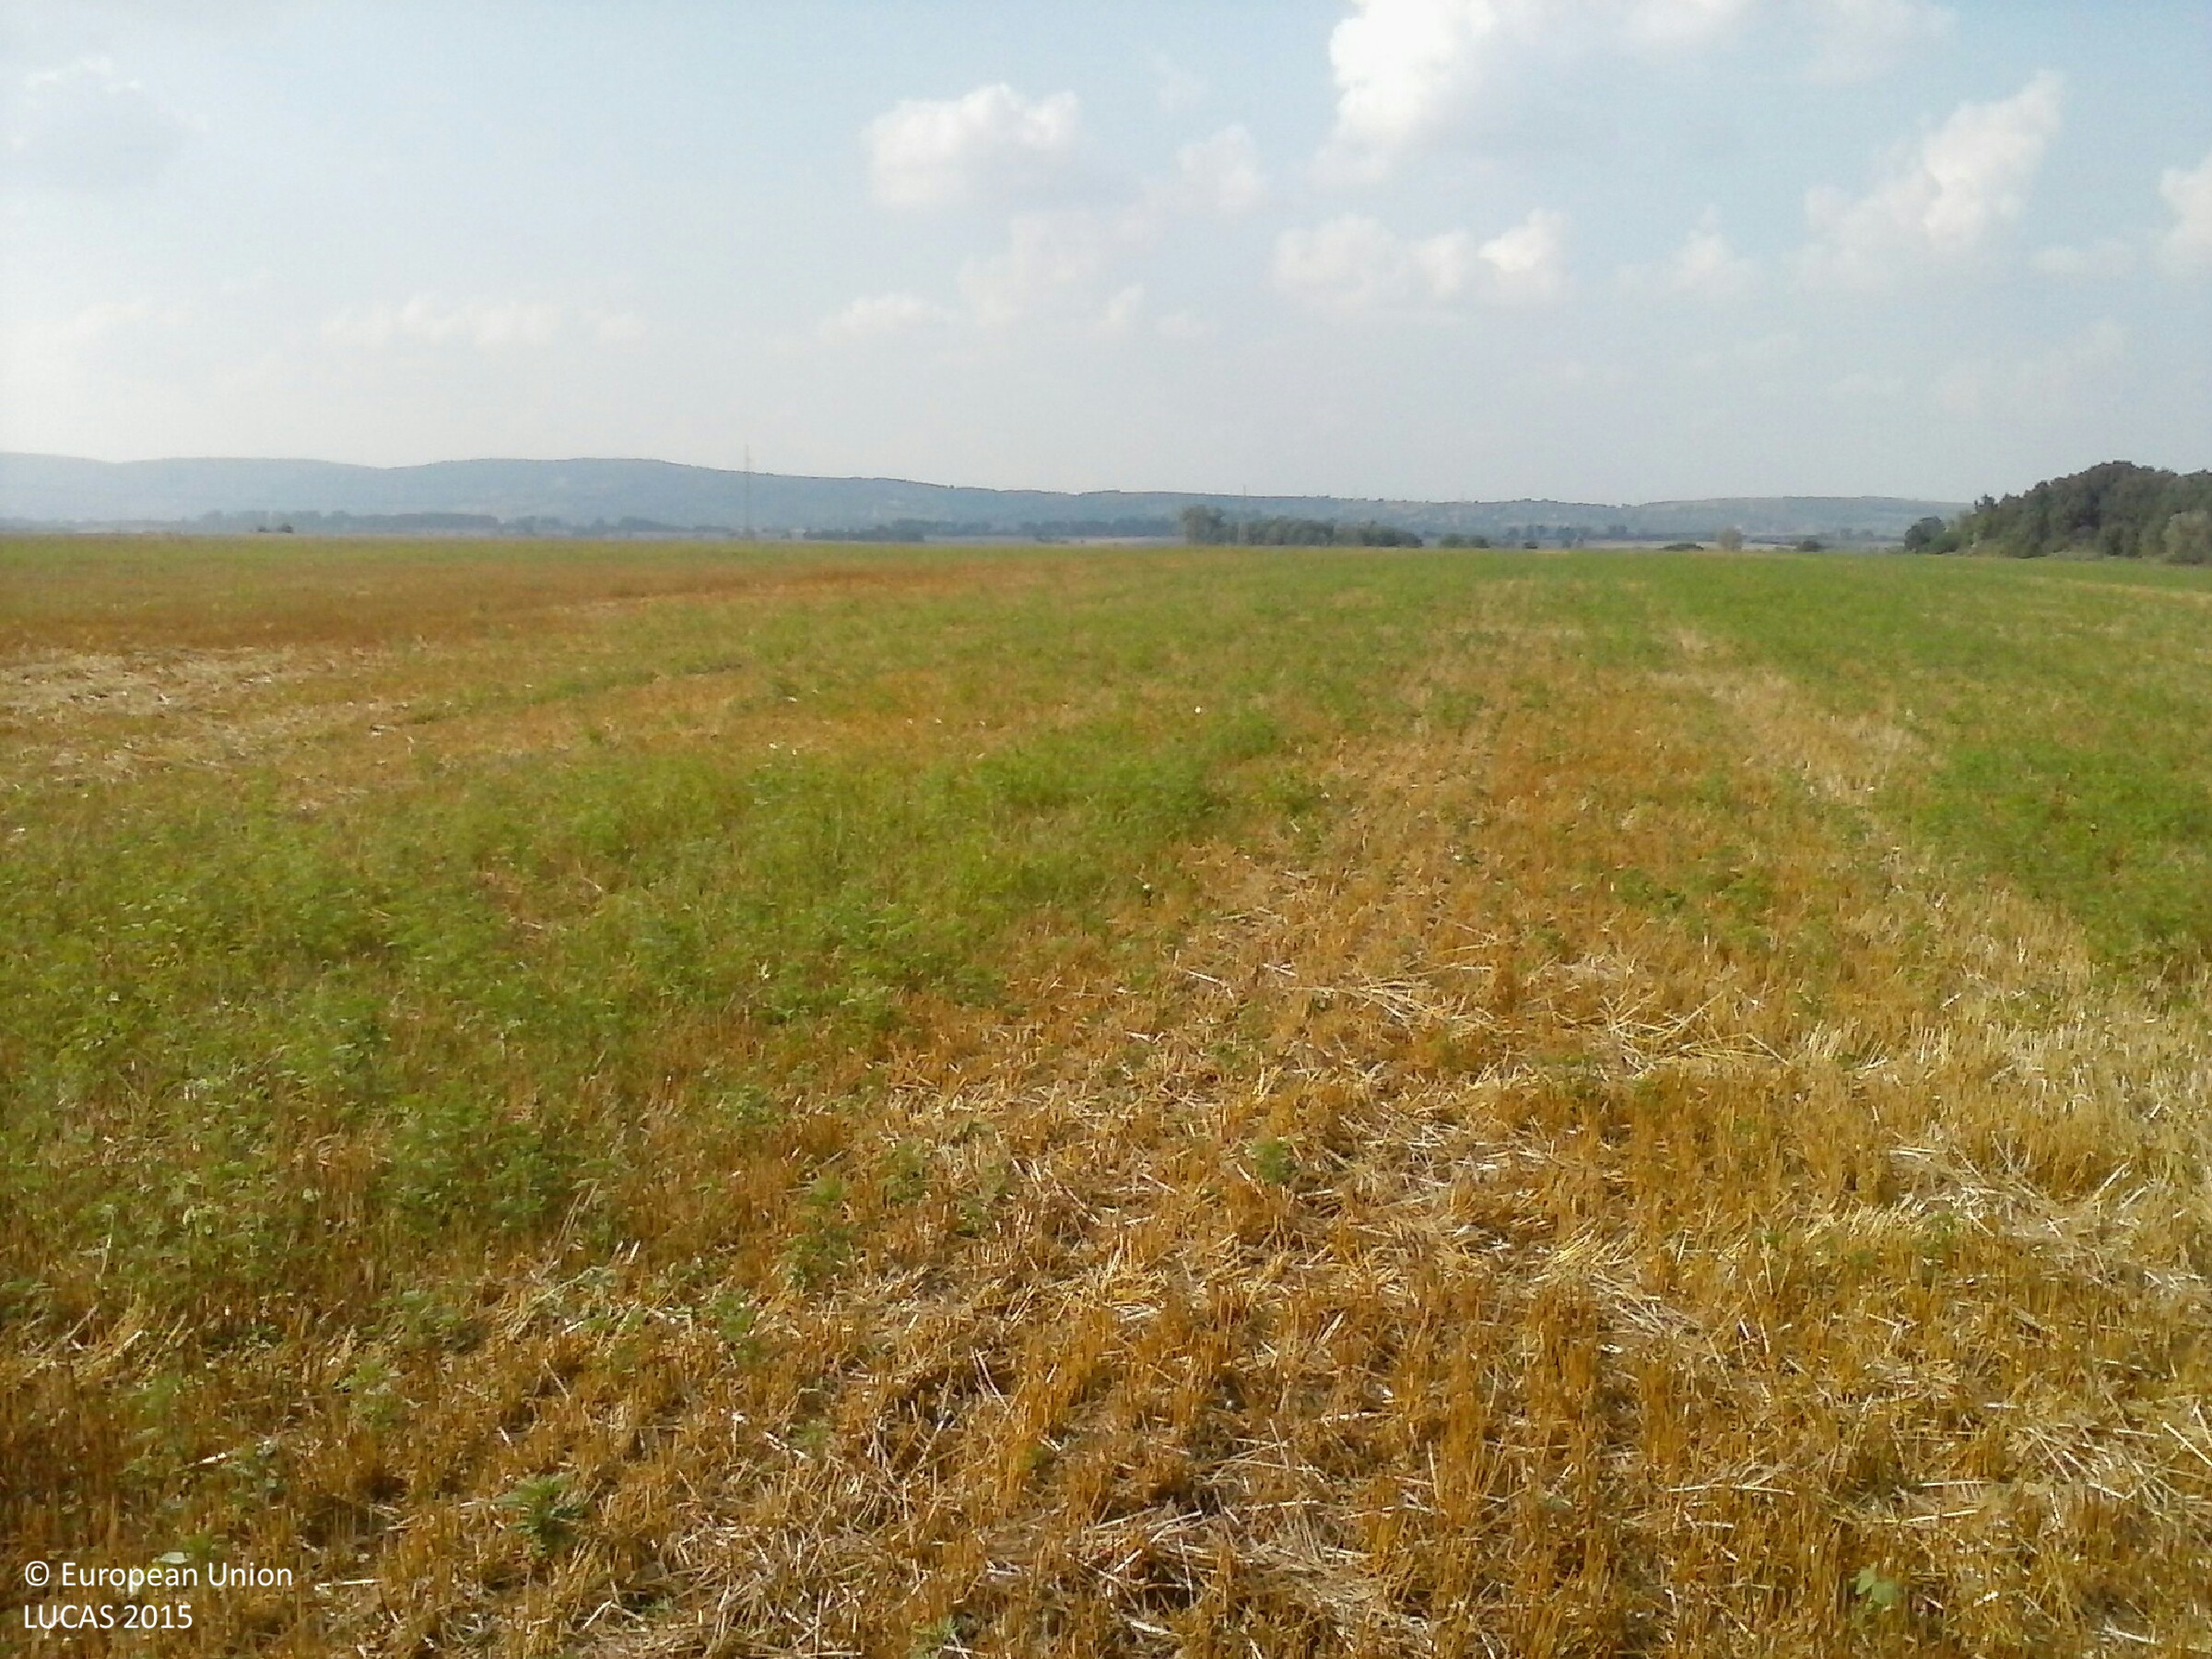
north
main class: Cropland
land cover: Common wheat
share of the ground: 10 - 25 %
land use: Agriculture (excluding fallow land and kitchen gardens)
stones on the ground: < 10 %
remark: Harvested field
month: April
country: HU
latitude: 45.8263
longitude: 18.3351
